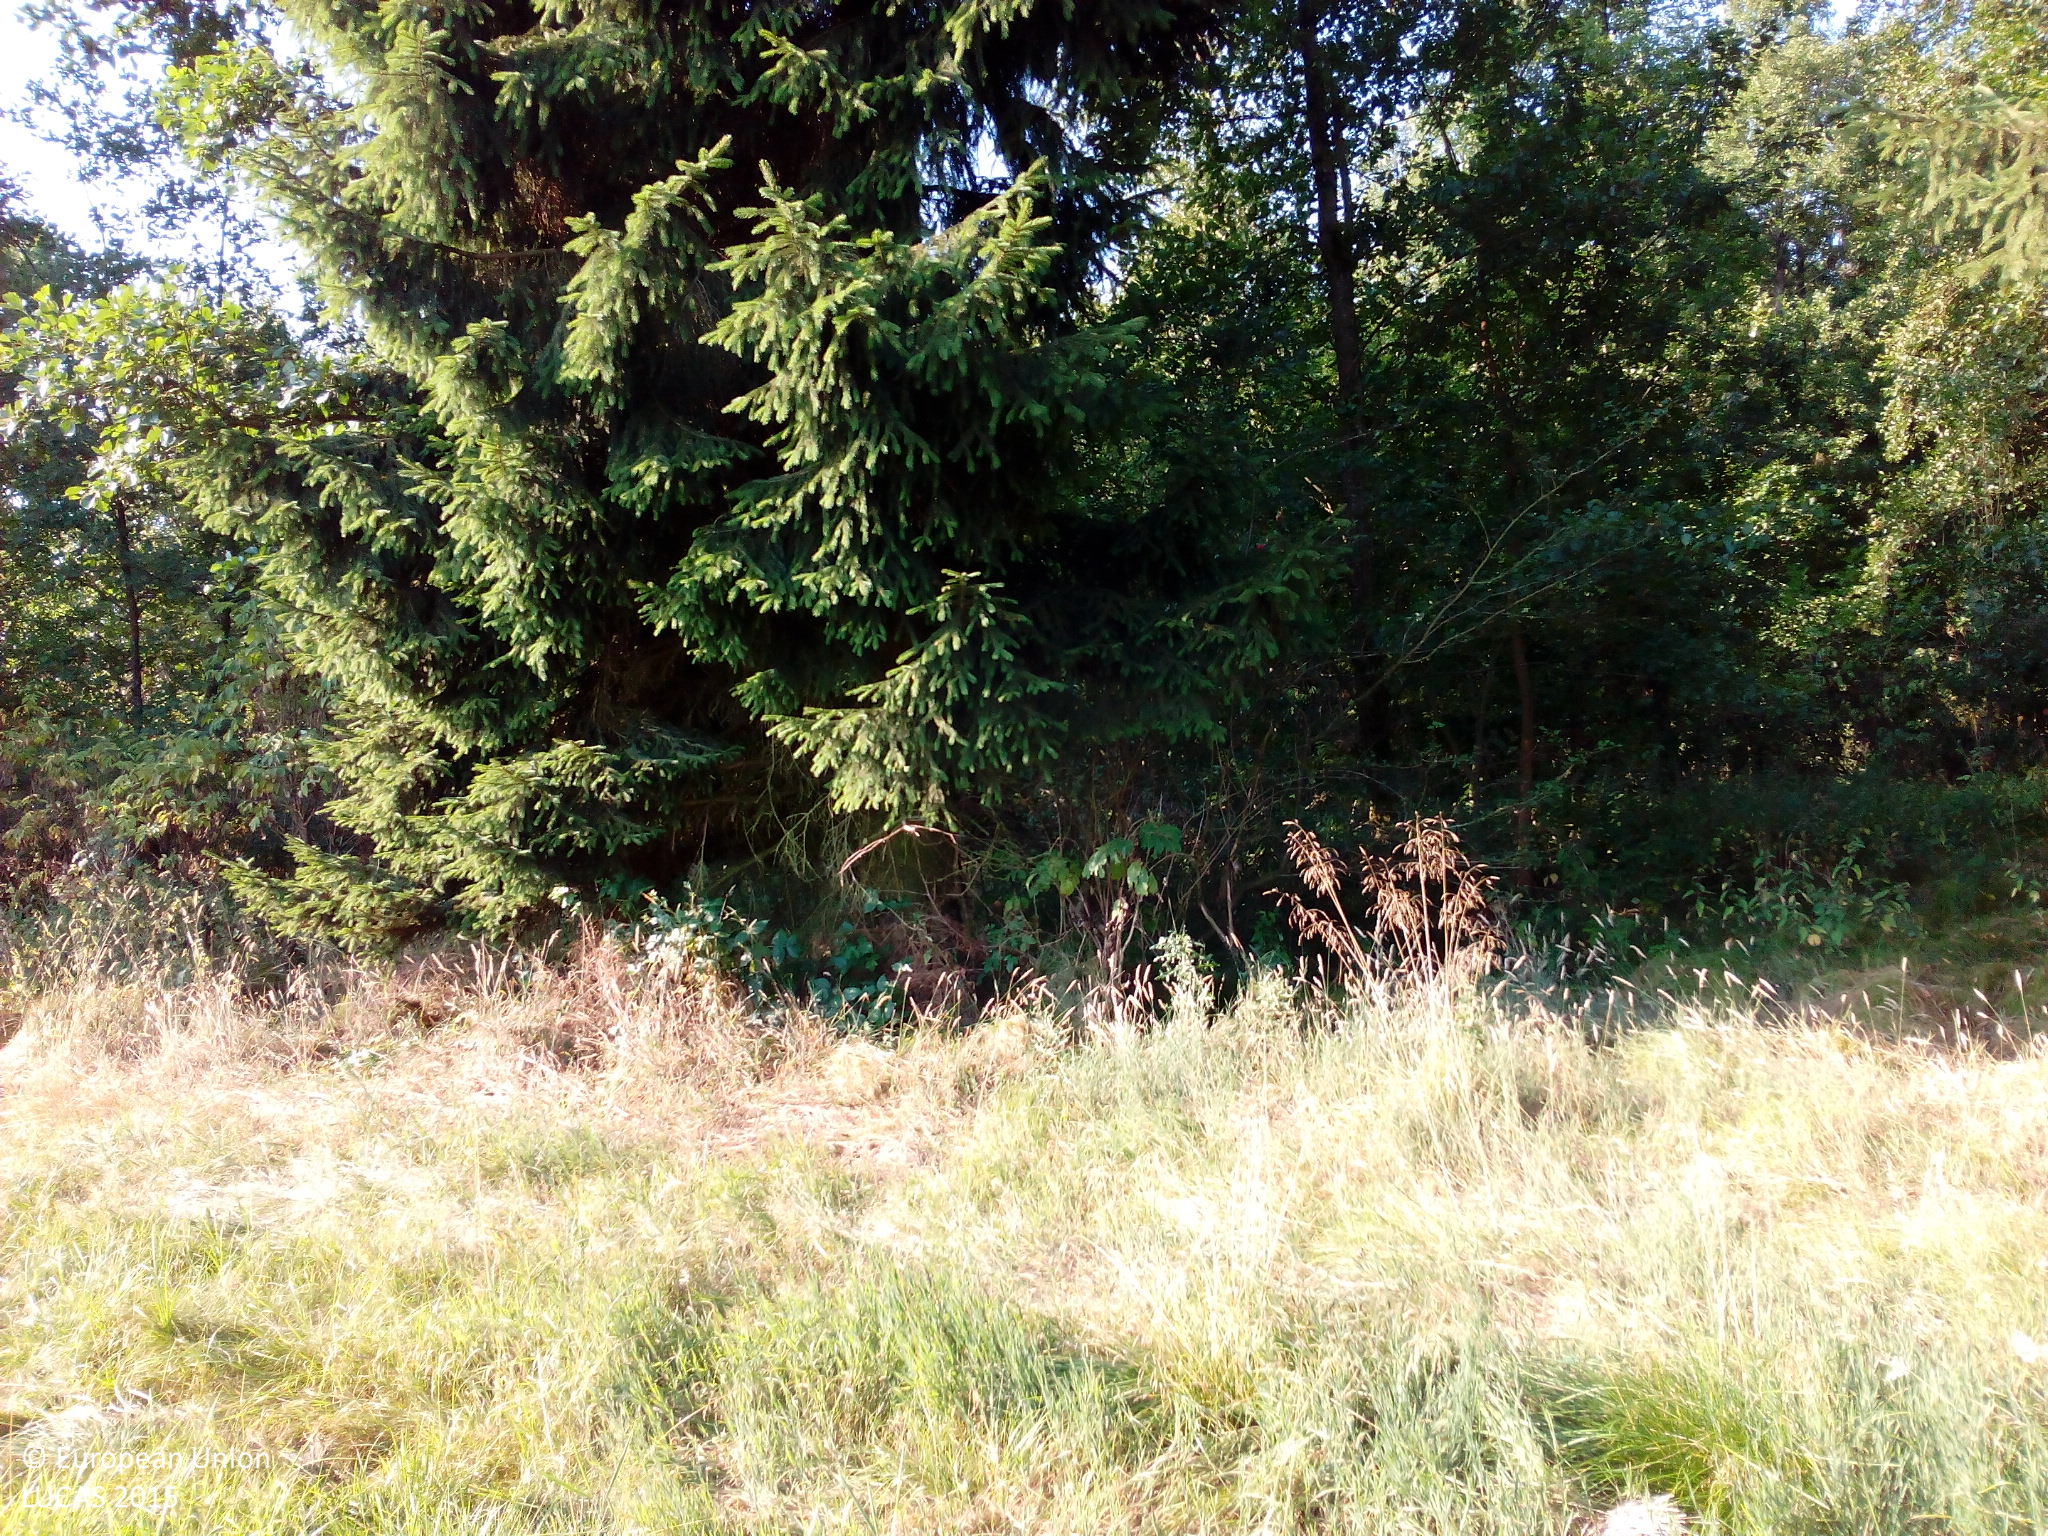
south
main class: Cropland
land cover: Maize
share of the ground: > 75 %
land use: Agriculture (excluding fallow land and kitchen gardens)
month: August
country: DE
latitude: 48.7441
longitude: 10.5301
